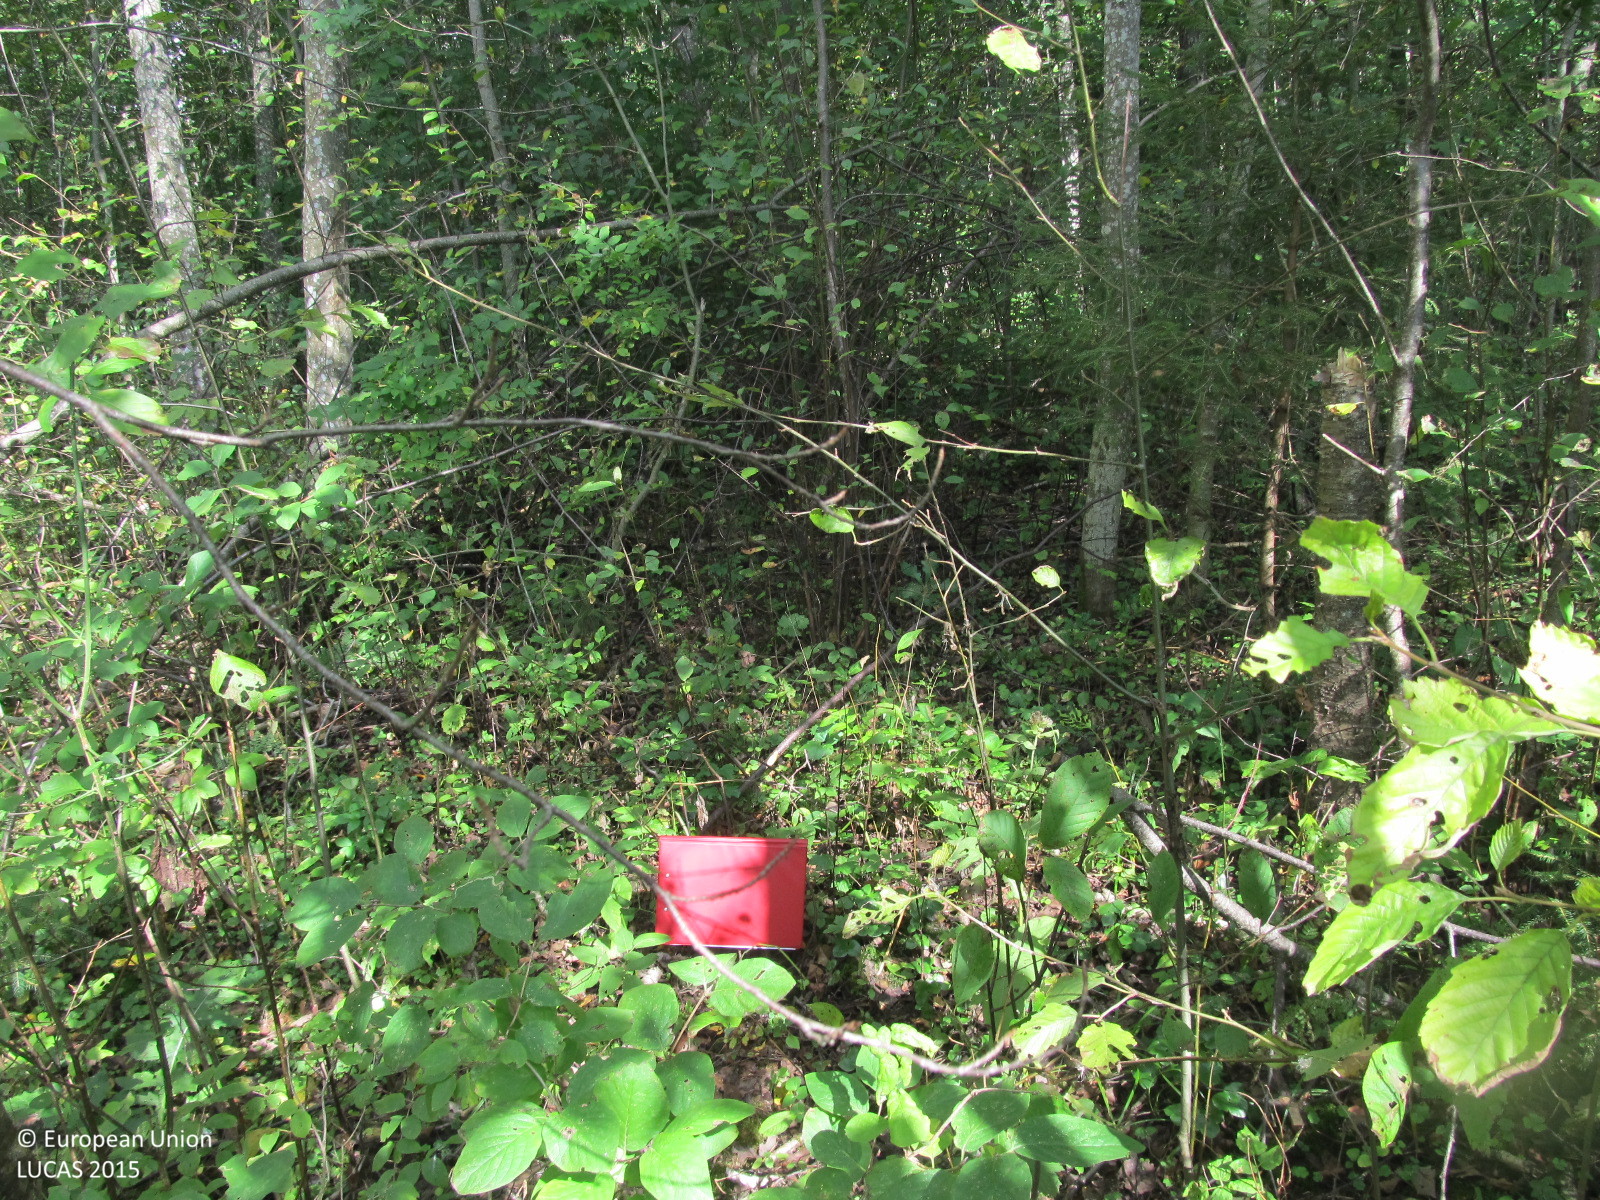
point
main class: Woodland
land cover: Broadleaved woodland
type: non-riverine alder, birch or aspen forest
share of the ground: > 75 %
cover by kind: broadleaved forest trees 75 %, shrubs 10 %, herbaceous plants 10 %, coniferous forest trees 5 %
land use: Forestry
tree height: > 5 m
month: September
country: LT
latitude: 56.0725
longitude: 23.3271
